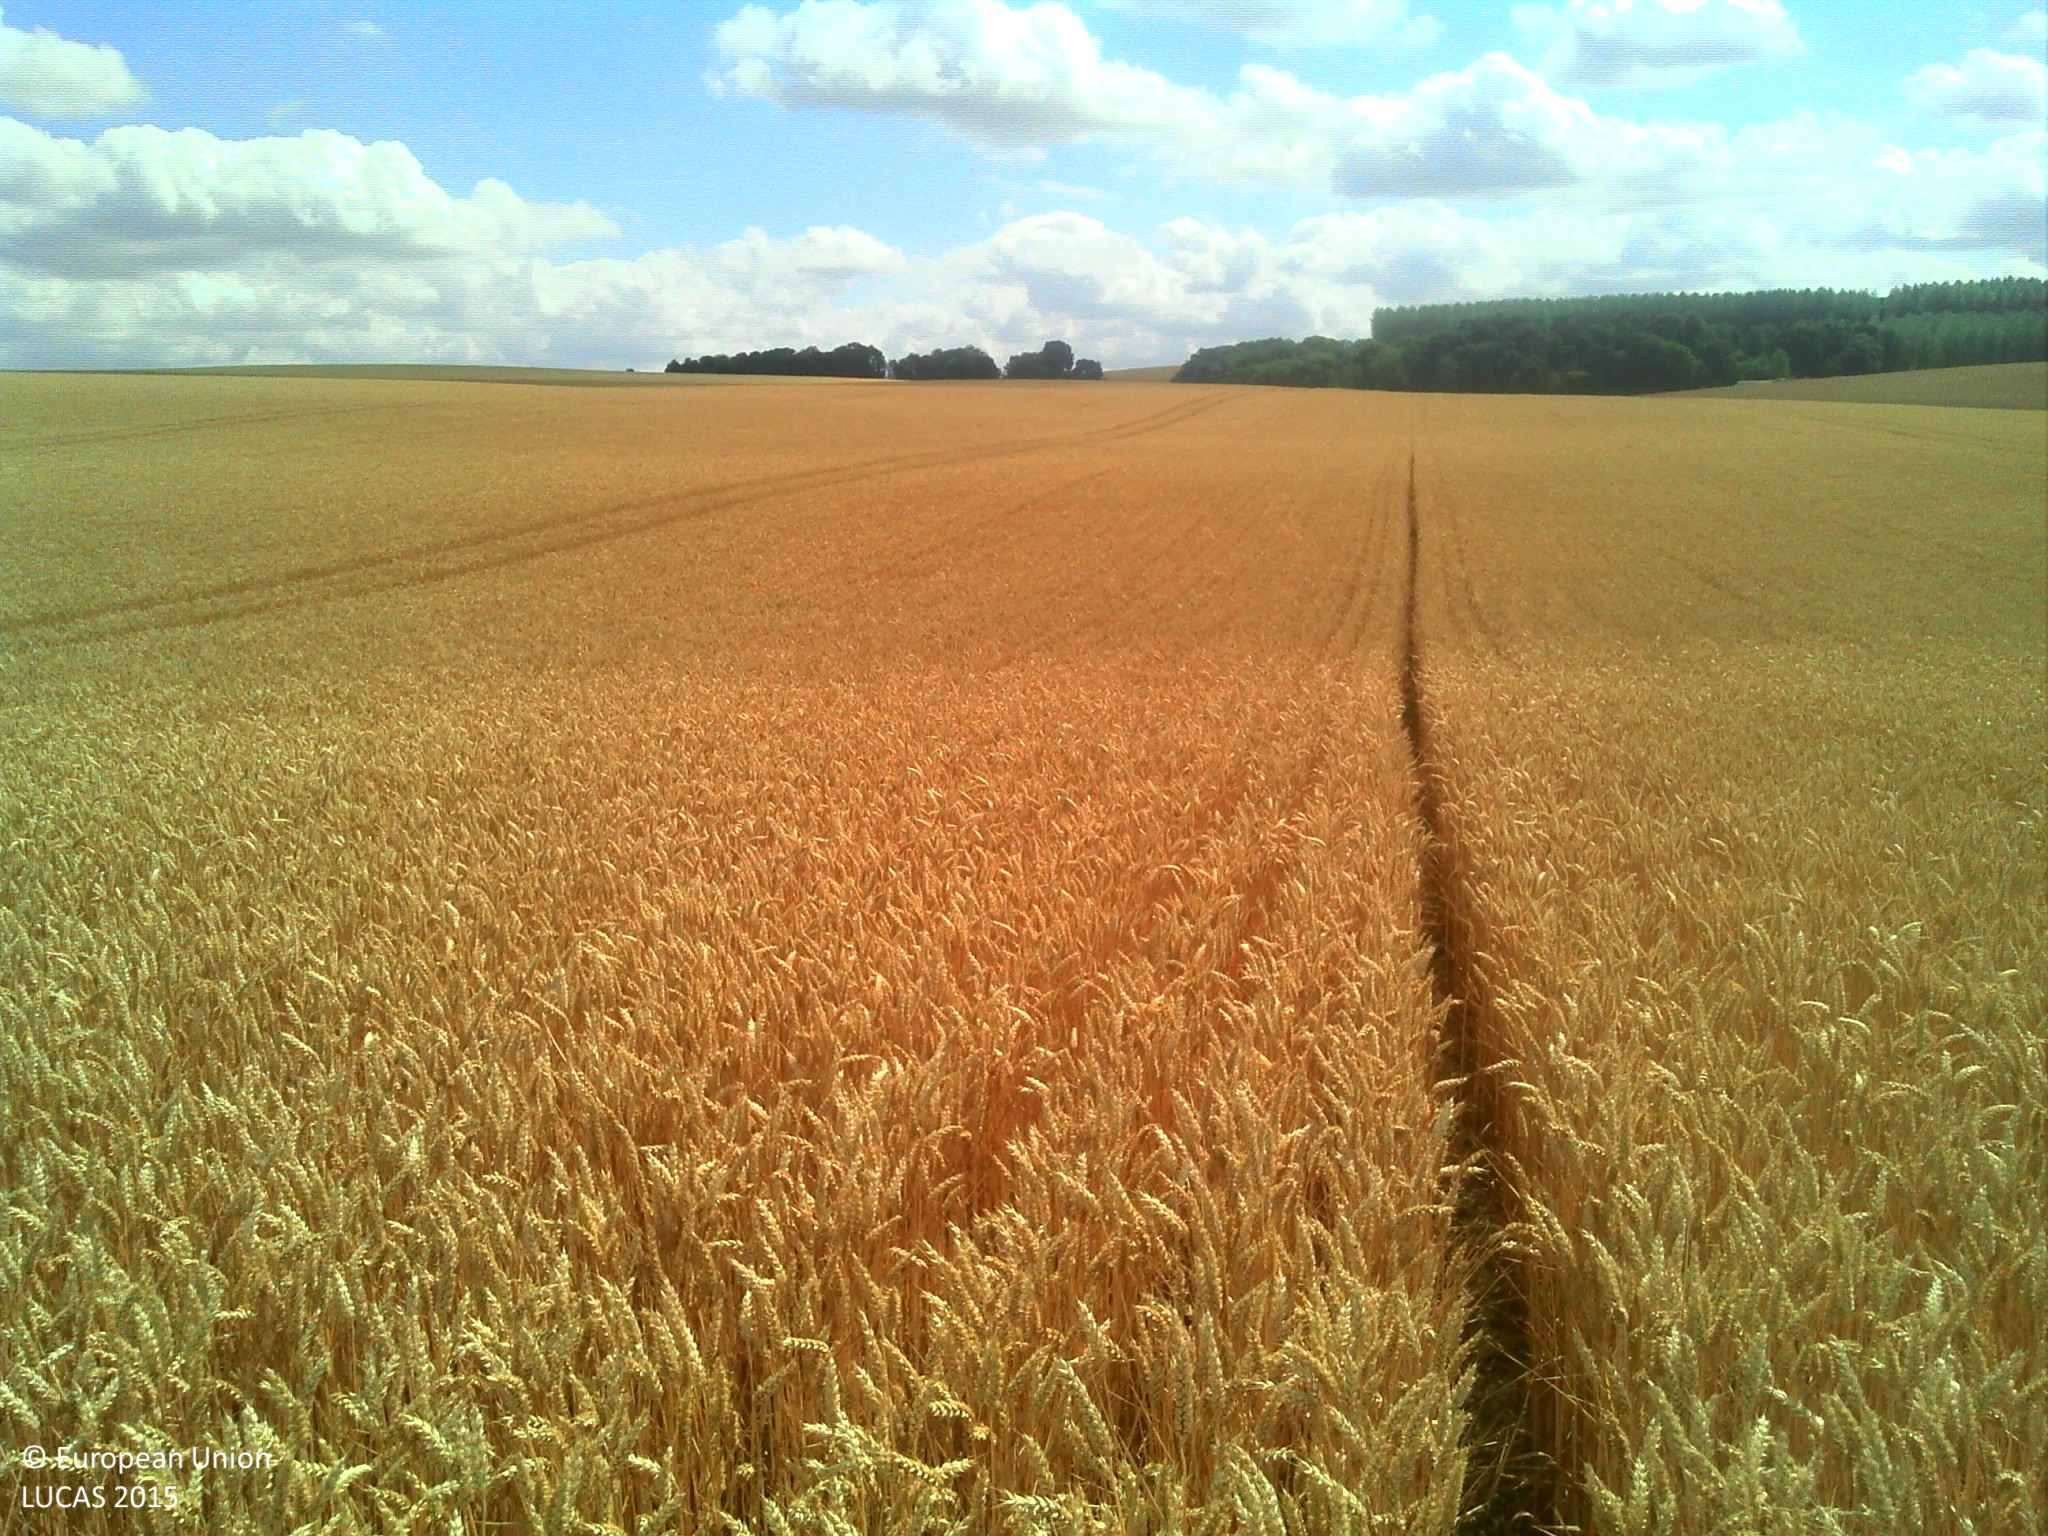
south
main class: Cropland
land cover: Common wheat
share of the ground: > 75 %
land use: Agriculture (excluding fallow land and kitchen gardens)
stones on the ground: < 10 %
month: July
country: FR
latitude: 49.2669
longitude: 3.3271
